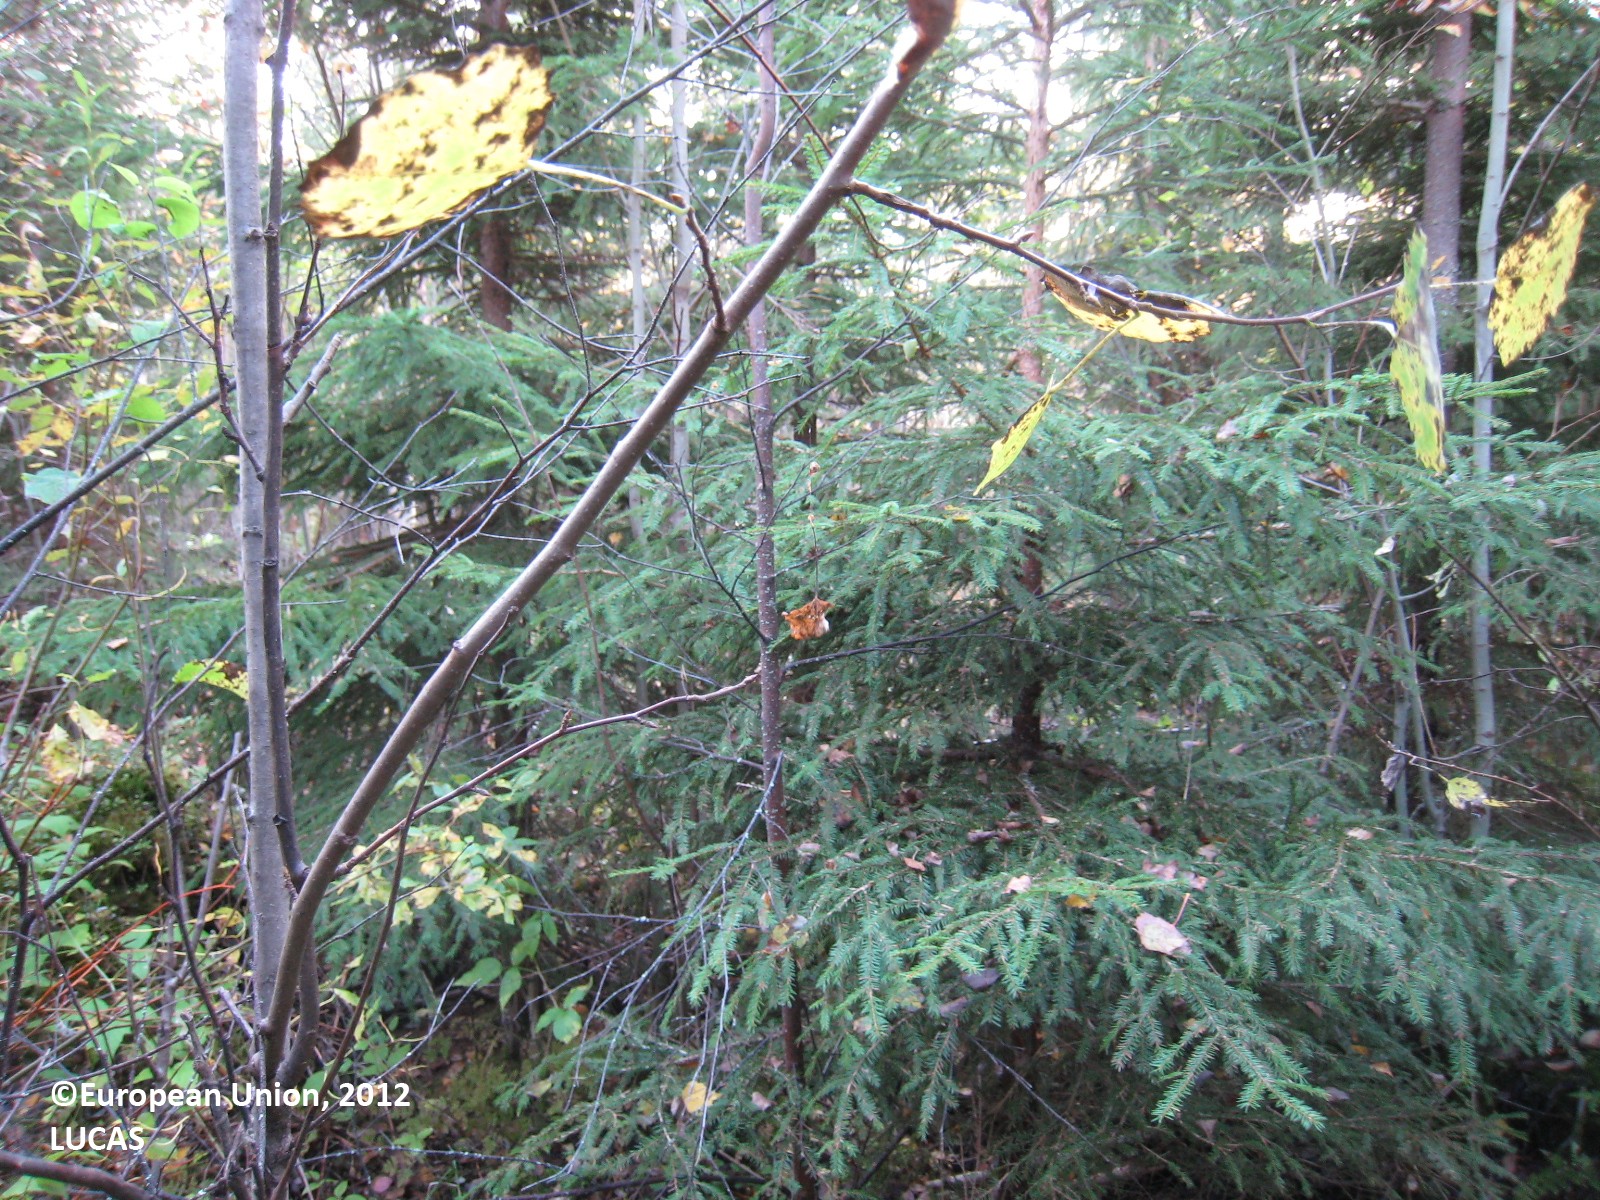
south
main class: Woodland
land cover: Spruce dominated mixed woodland
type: boreal forest
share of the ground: > 75 %
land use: Forestry
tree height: > 5 m
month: September
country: FI
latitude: 62.6409
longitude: 26.6208
